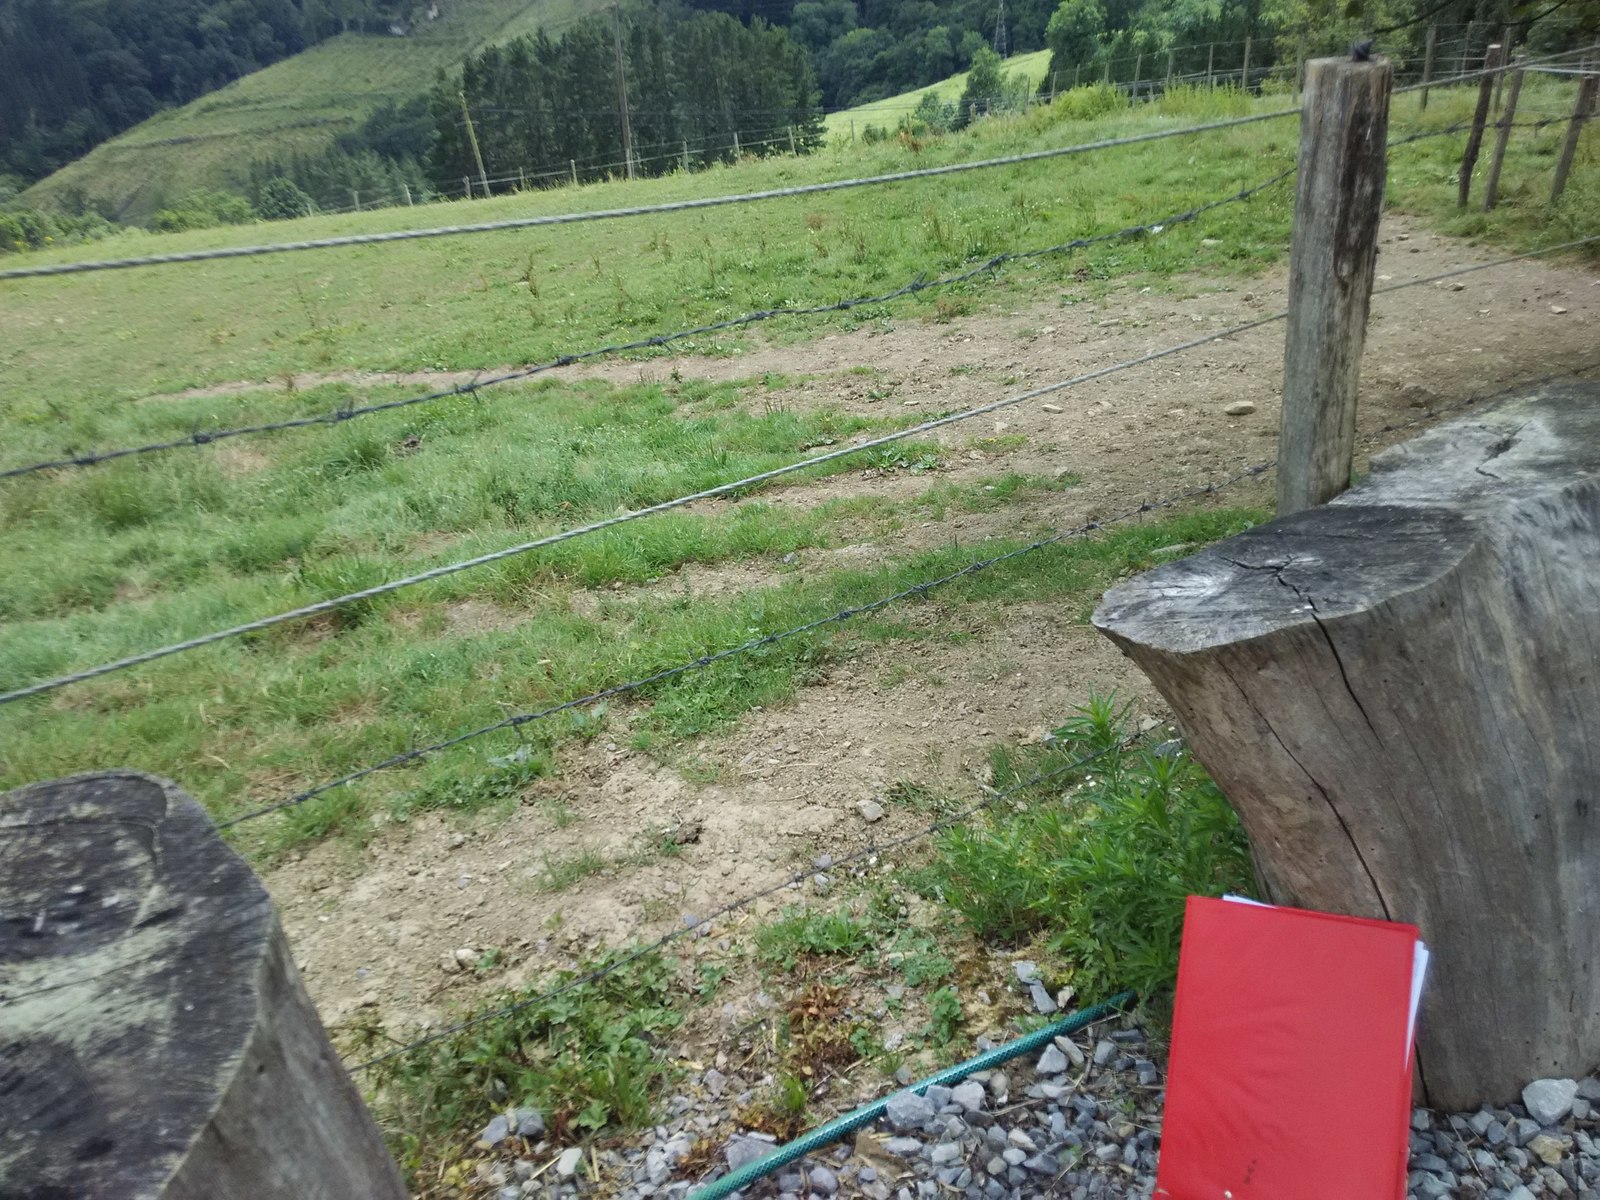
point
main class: Grassland
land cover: Grassland without tree/shrub cover
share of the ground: 50 - 75 %
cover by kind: herbaceous plants 70 %
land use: Agriculture (excluding fallow land and kitchen gardens)
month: July
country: ES
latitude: 43.1378
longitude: -2.4811
